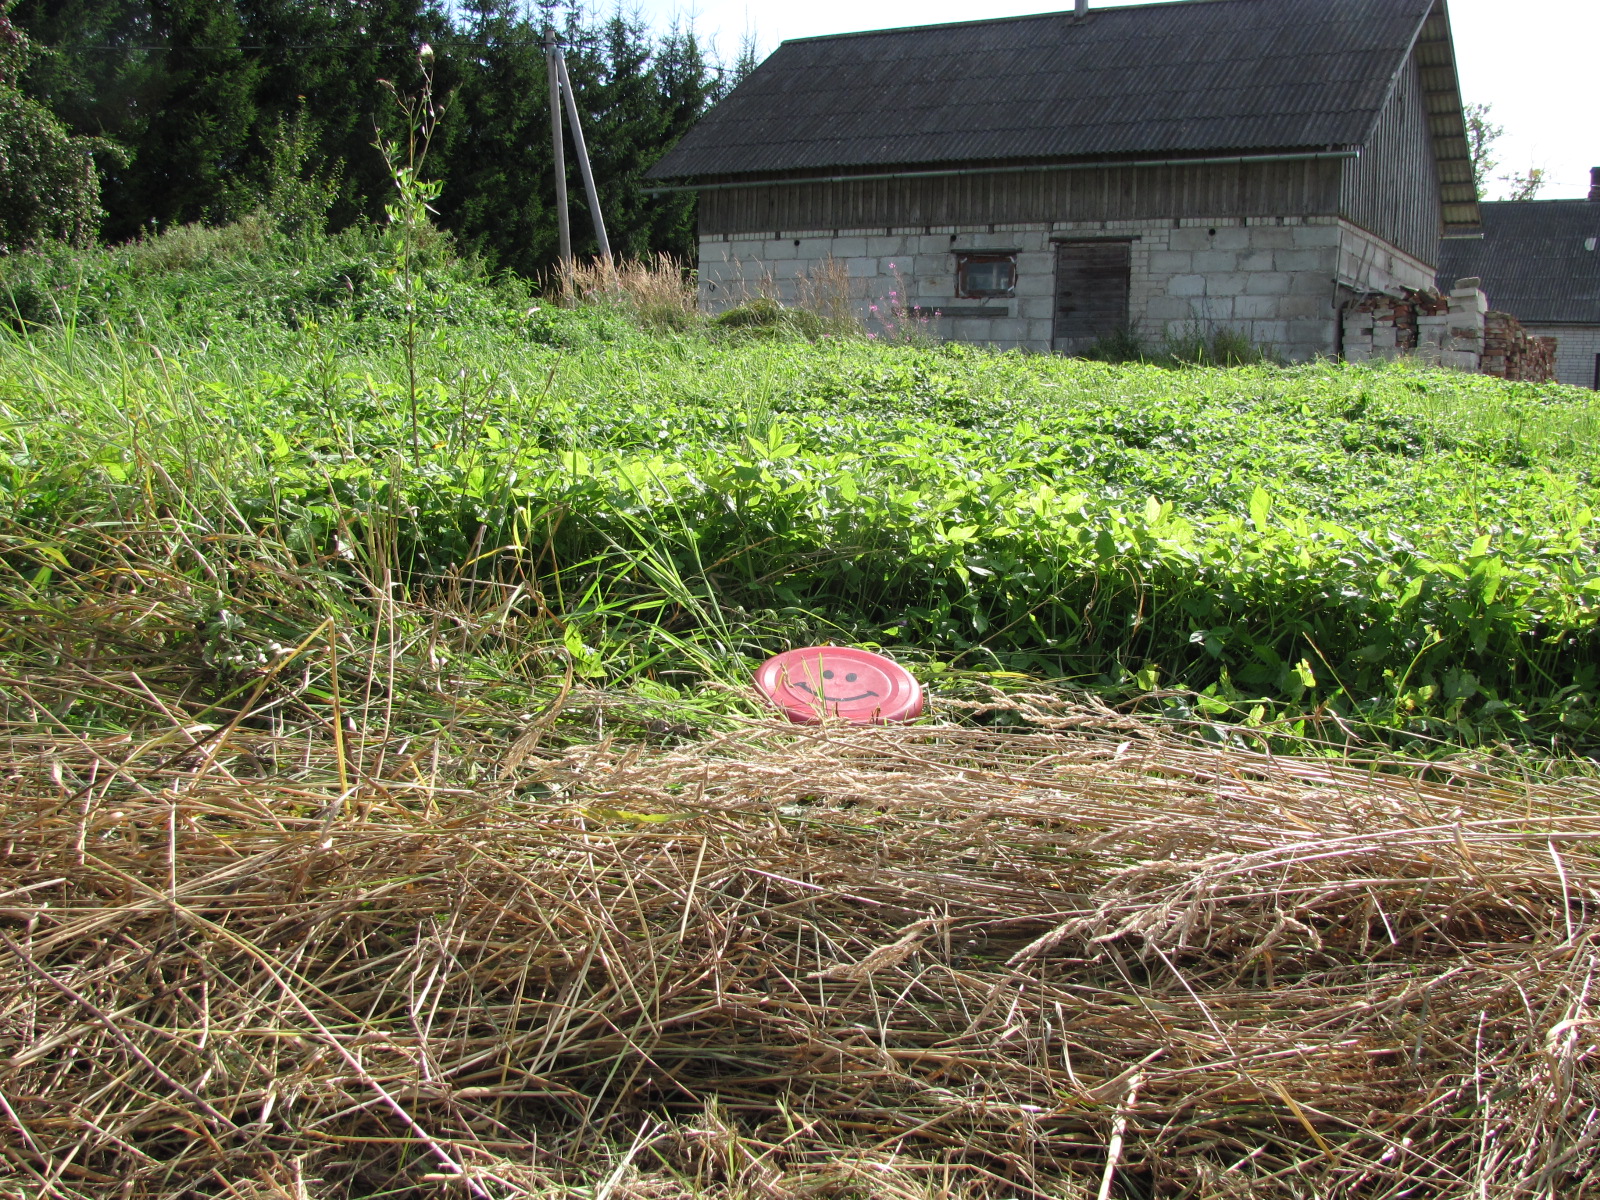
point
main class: Grassland
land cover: Grassland without tree/shrub cover
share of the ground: > 75 %
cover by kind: herbaceous plants 100 %
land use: Agriculture (excluding fallow land and kitchen gardens)
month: August
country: LV
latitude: 56.8891
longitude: 25.1949
